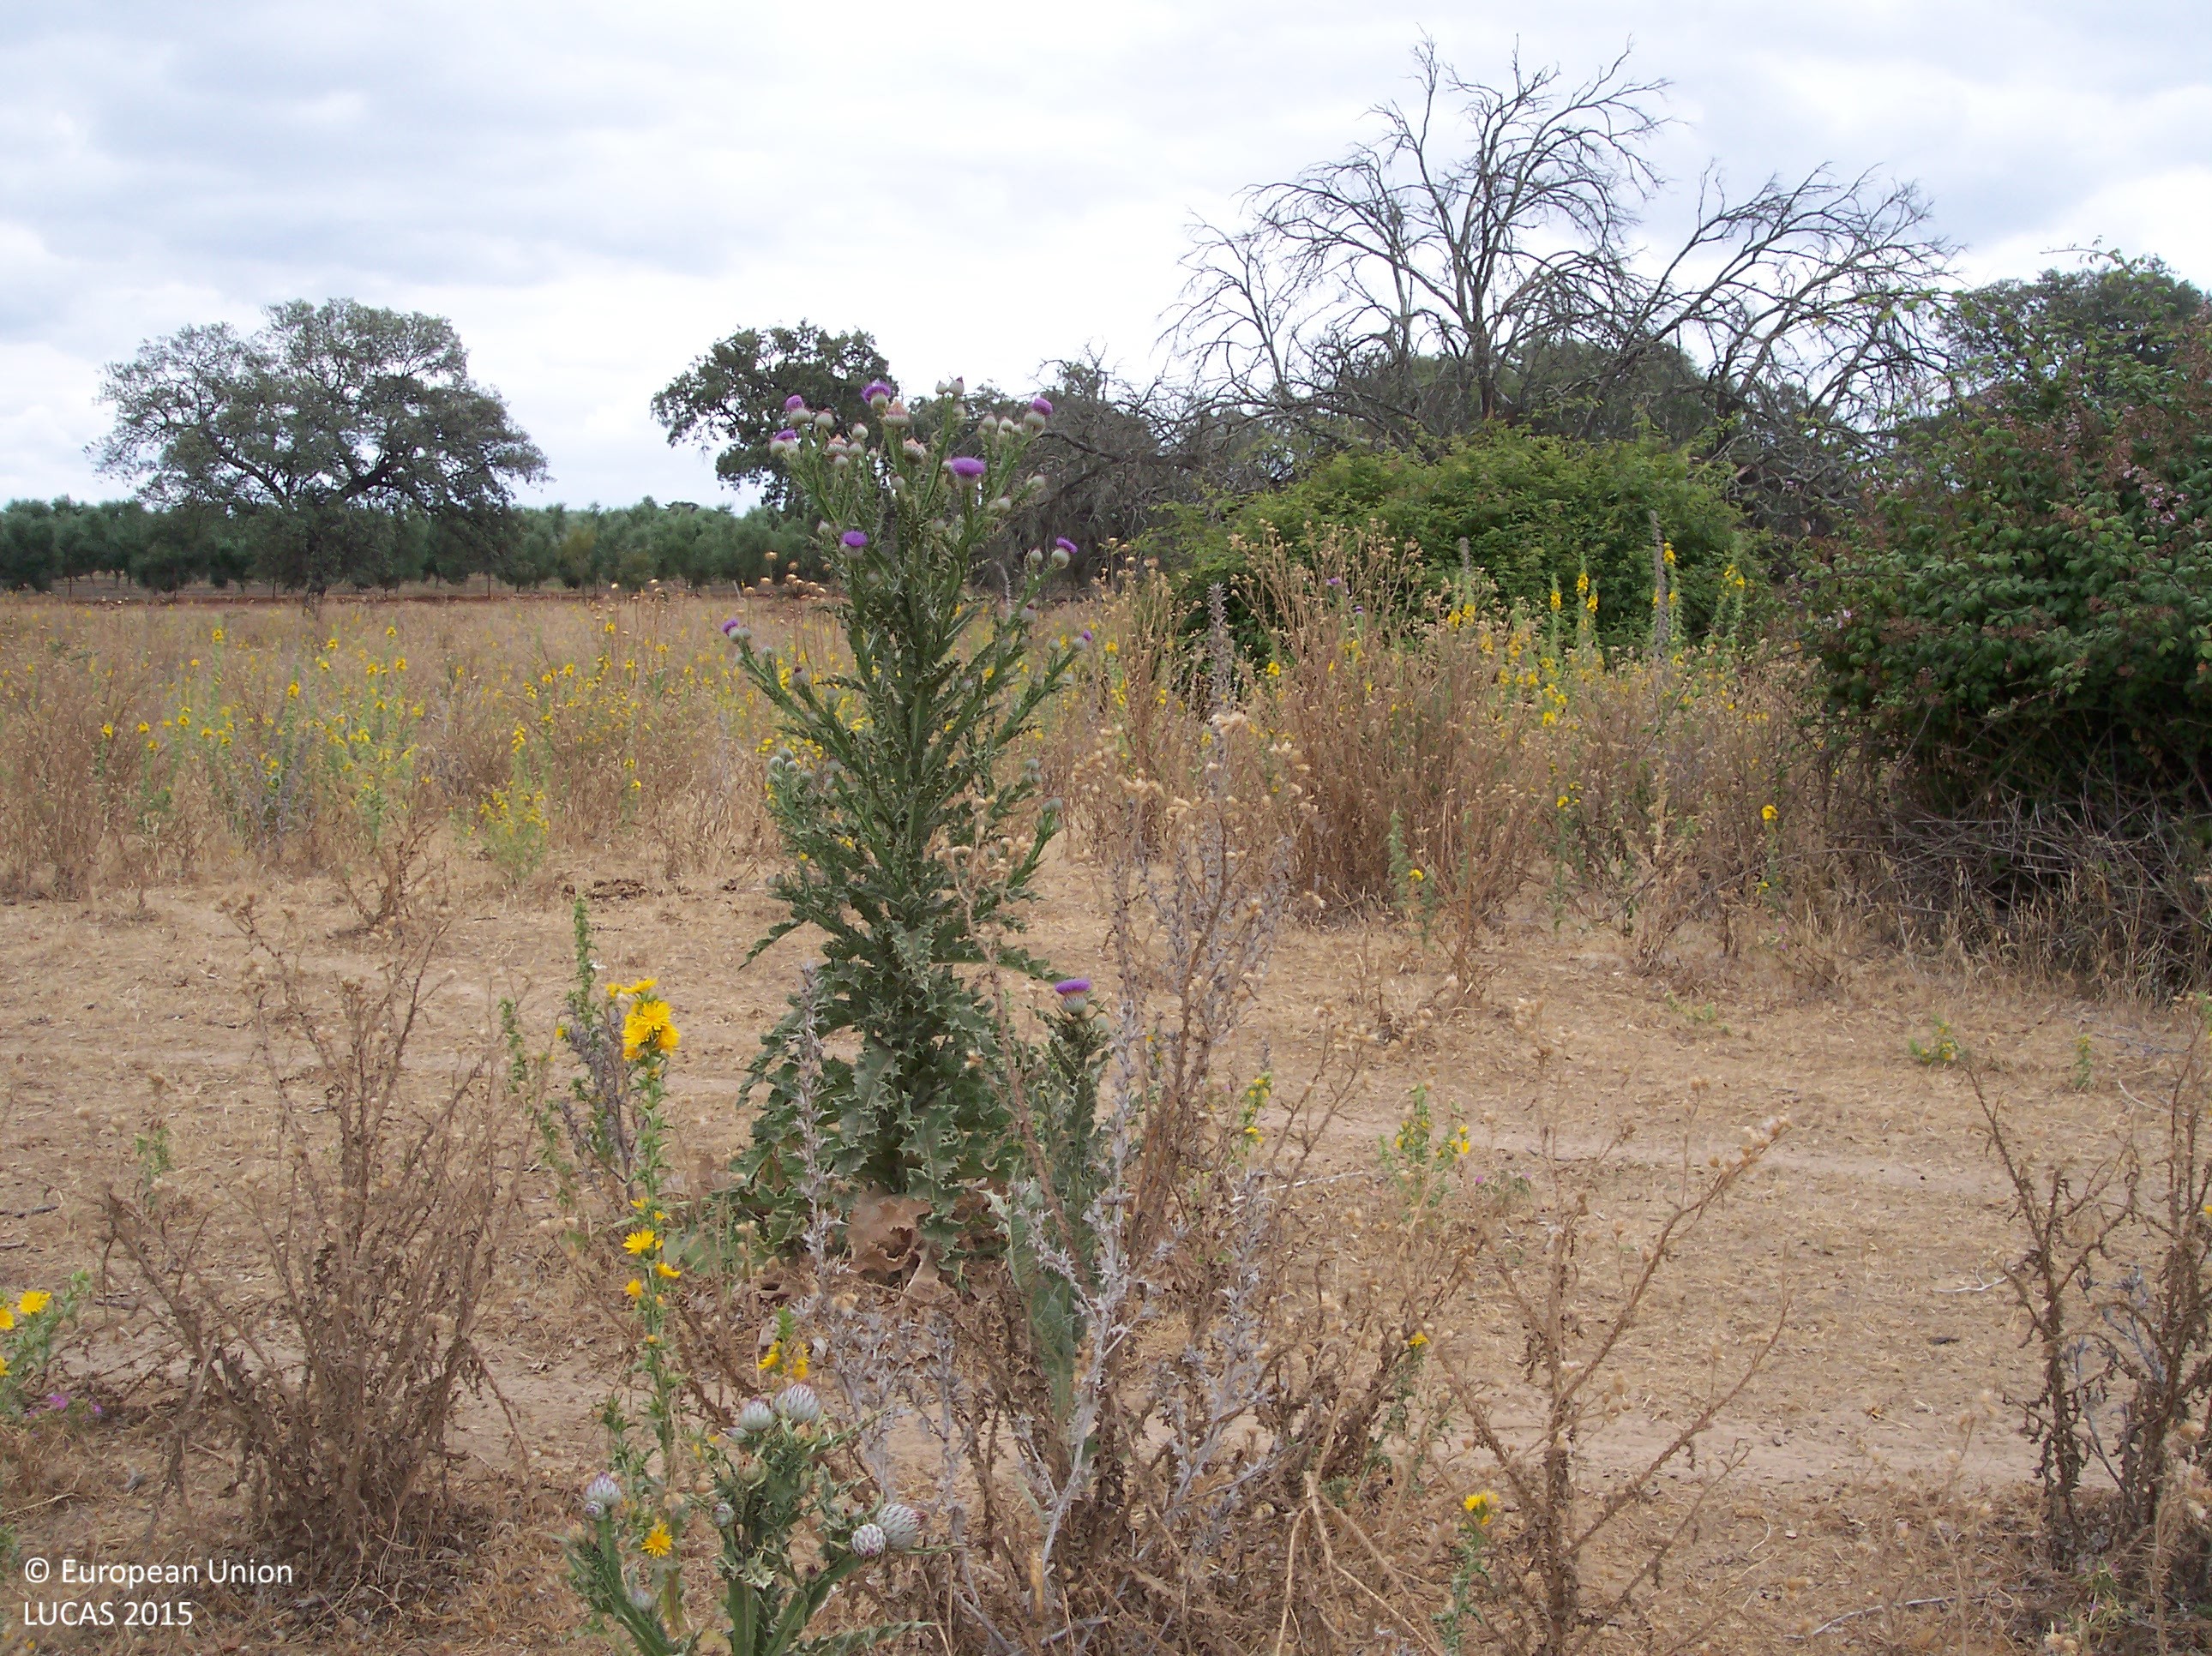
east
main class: Shrubland
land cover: Shrubland with sparse tree cover
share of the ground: 25 - 50 %
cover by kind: unconsolidated bare surface 60 %, shrubs 20 %, herbaceous plants 15 %, broadleaved forest trees 5 %
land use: Agriculture (excluding fallow land and kitchen gardens)
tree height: > 5 m
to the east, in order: Shrubland with sparse tree cover; Fences; Olive groves; Fences; Other bare soil
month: June
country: ES
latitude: 37.3273
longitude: -6.4049
